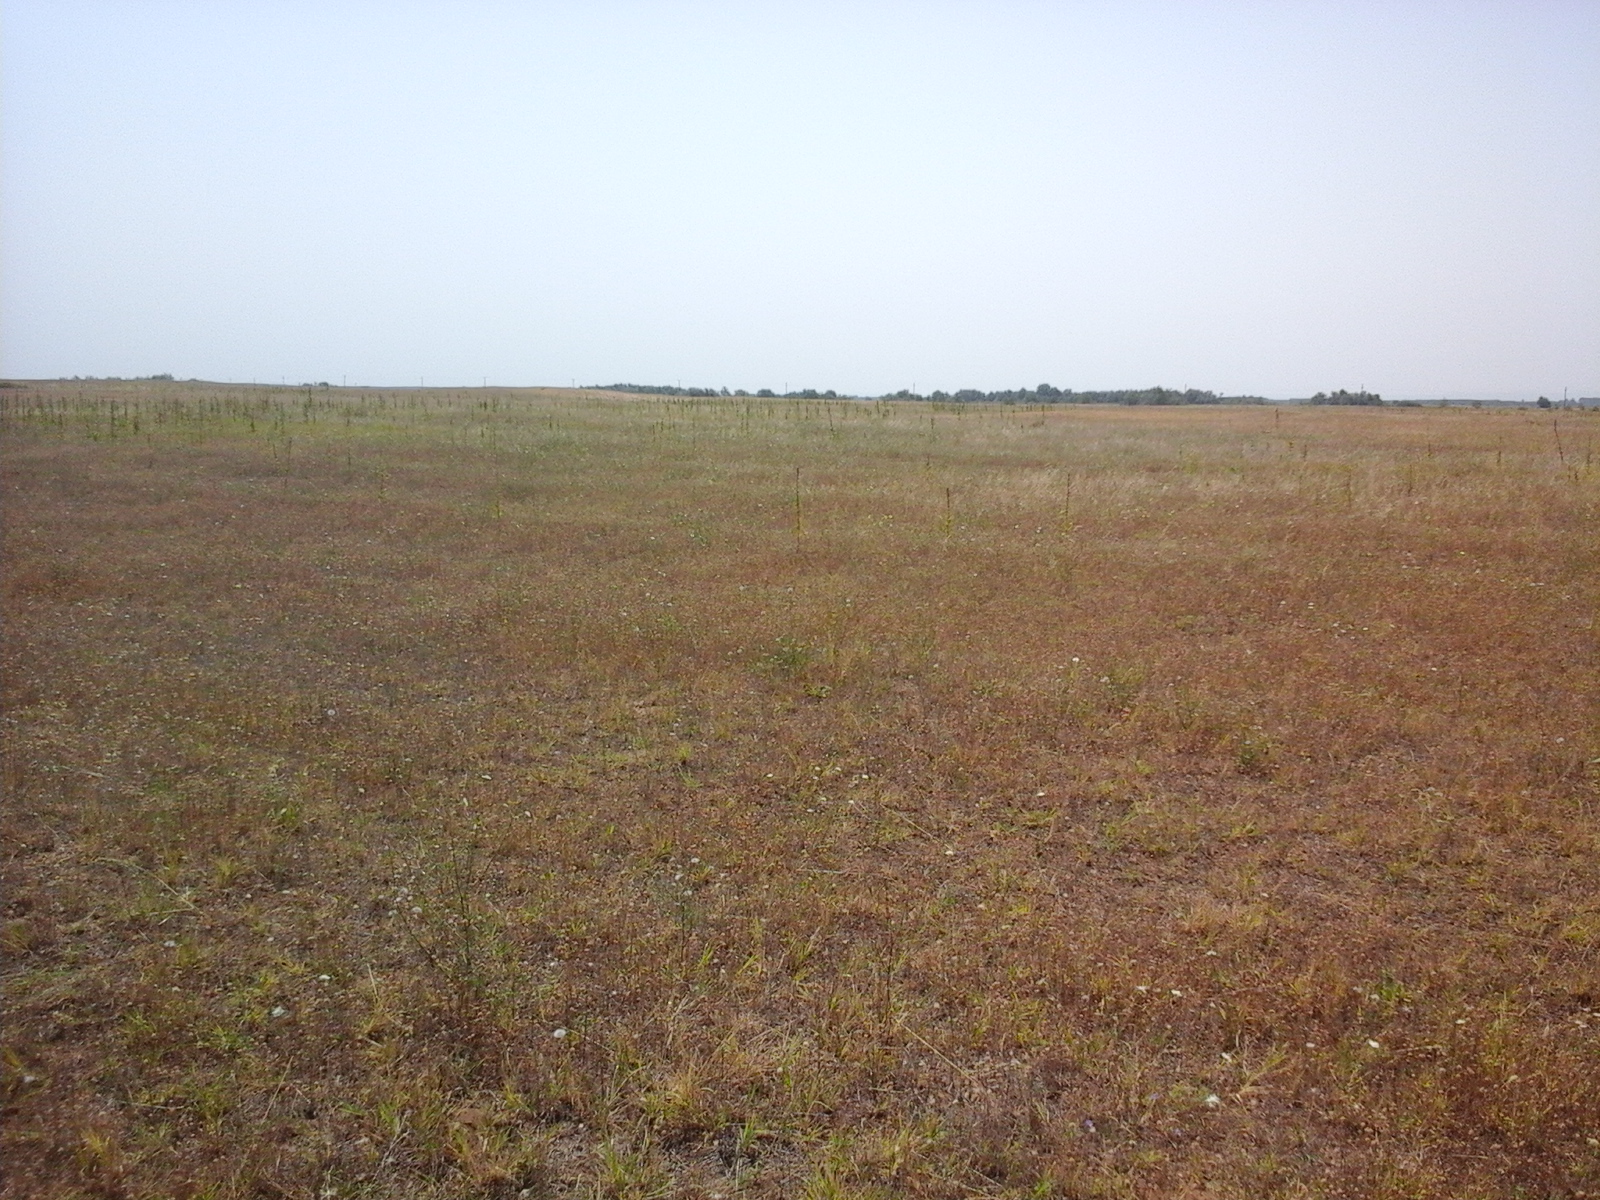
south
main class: Grassland
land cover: Grassland without tree/shrub cover
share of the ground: > 75 %
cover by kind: herbaceous plants 100 %
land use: Agriculture (excluding fallow land and kitchen gardens)
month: August
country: RO
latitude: 44.3959
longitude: 22.6317
